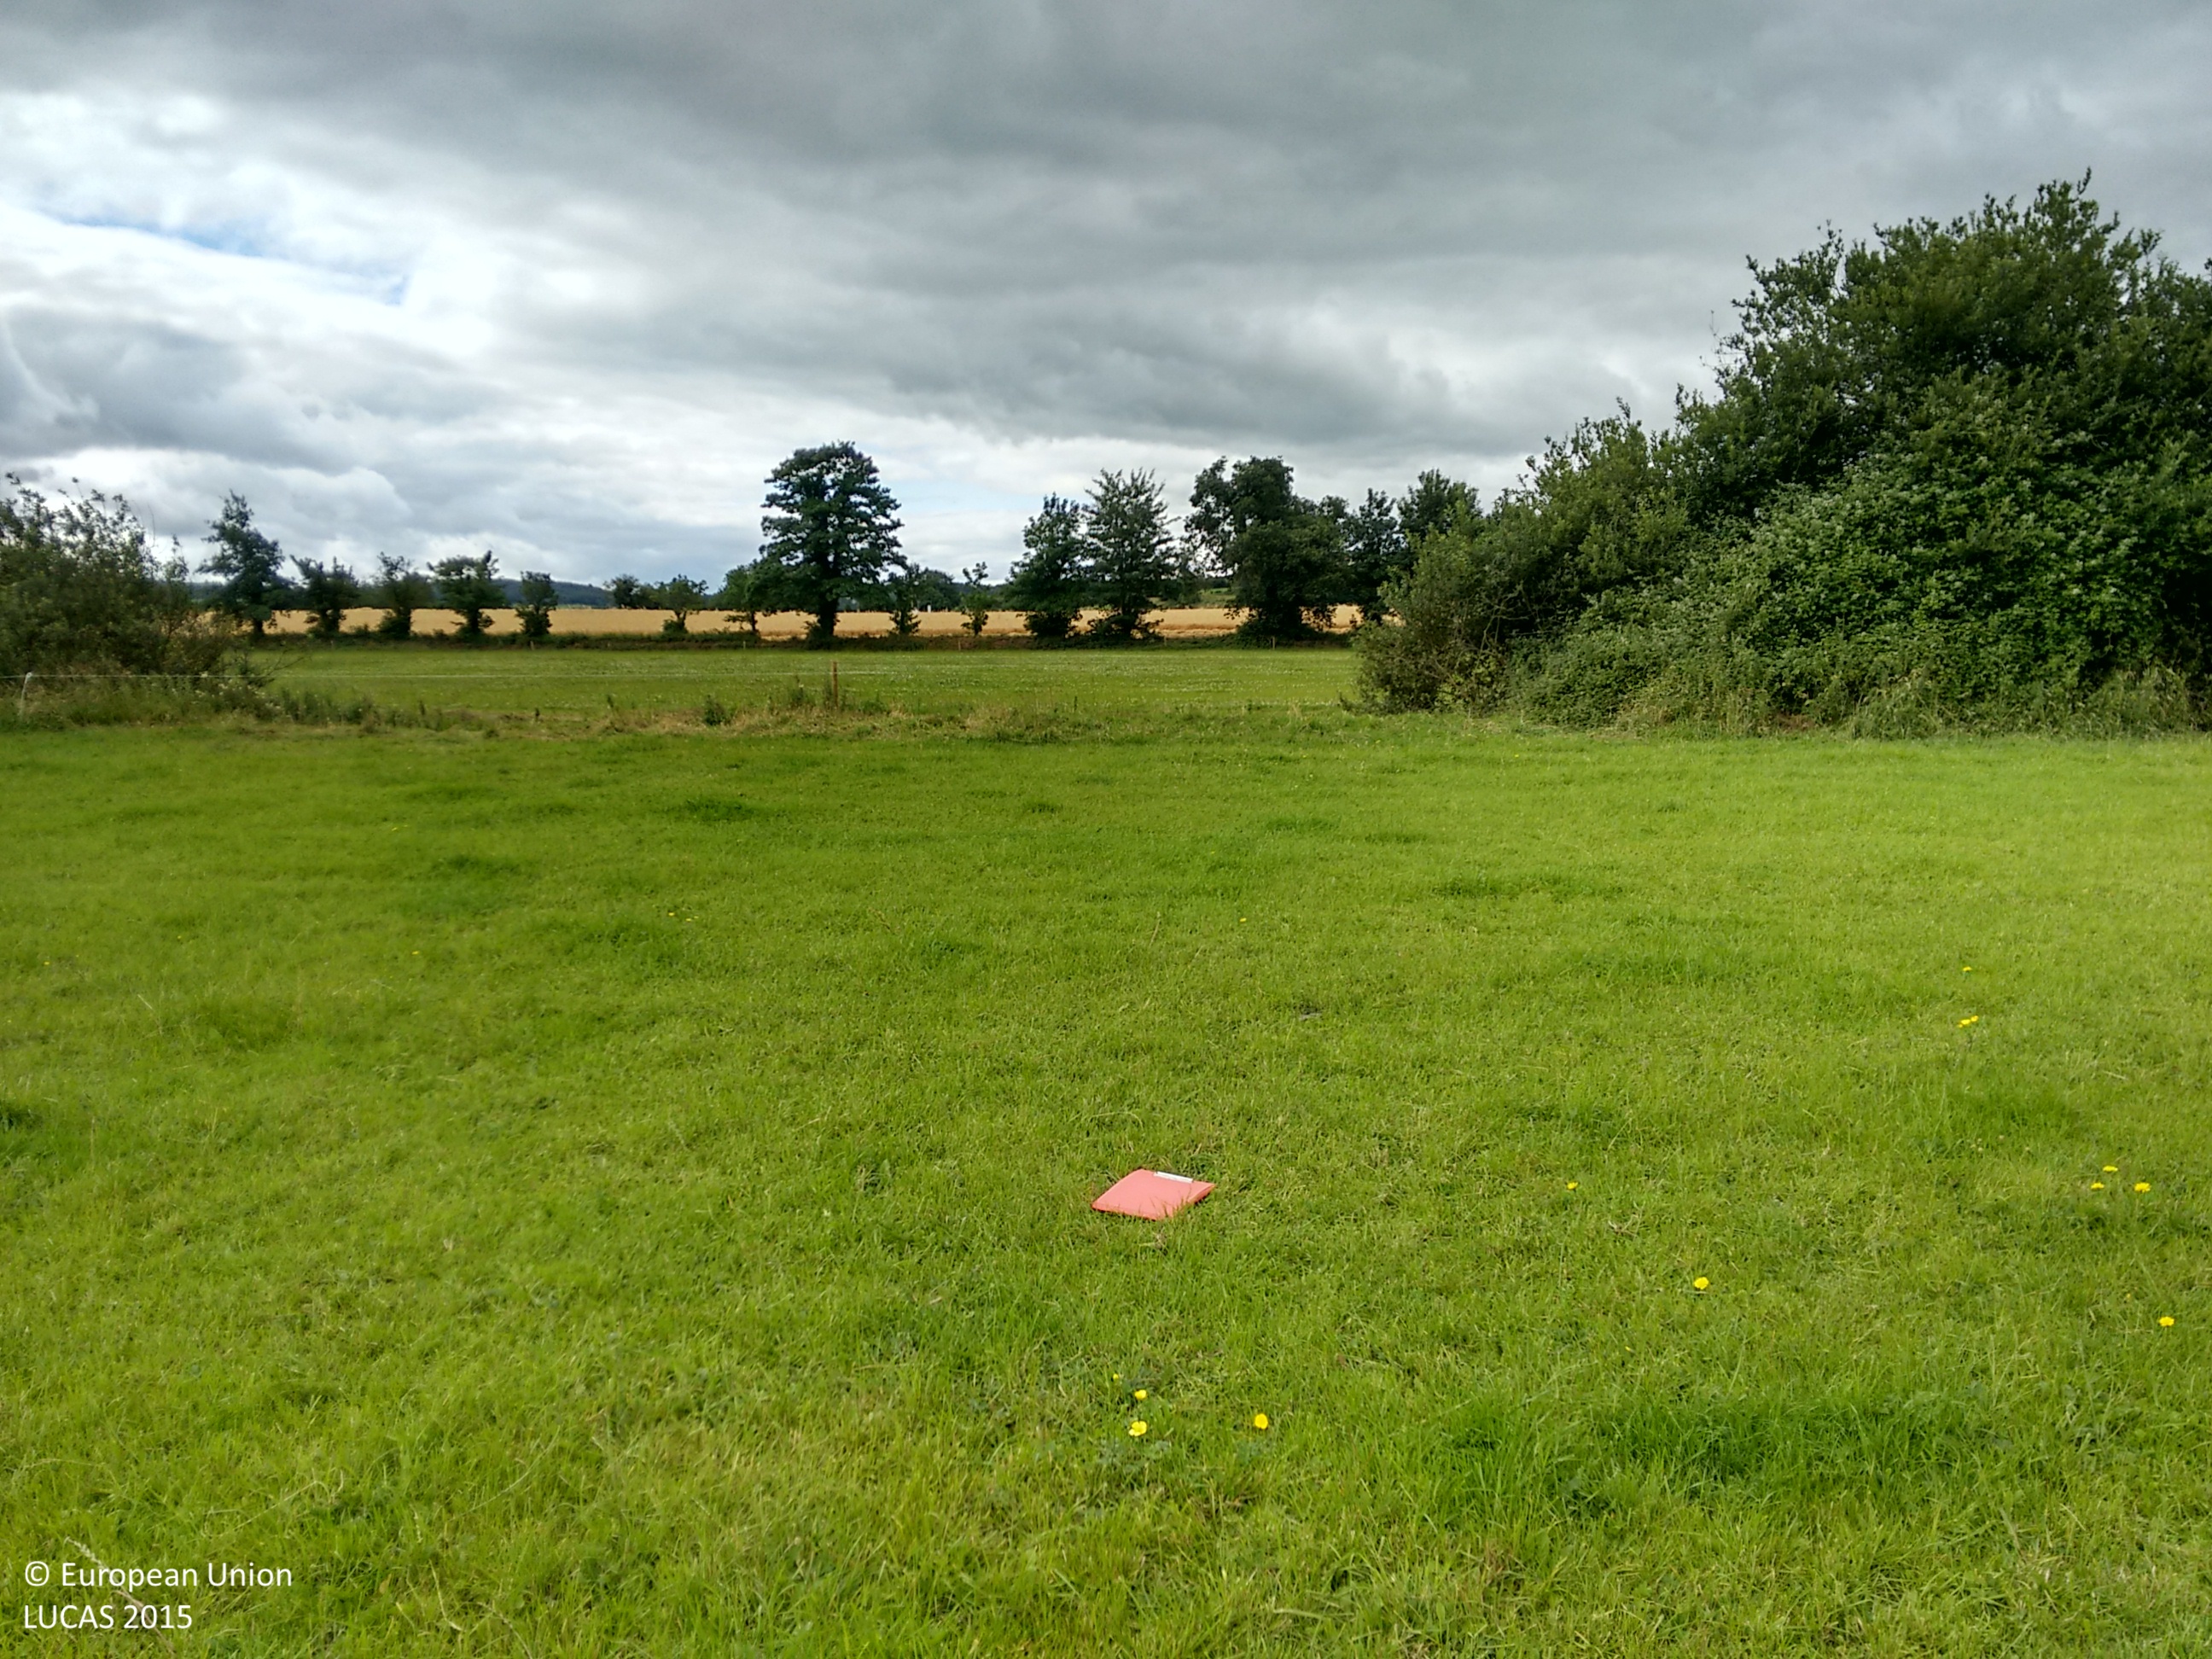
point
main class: Grassland
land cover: Grassland without tree/shrub cover
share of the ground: > 75 %
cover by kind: herbaceous plants 100 %
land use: Agriculture (excluding fallow land and kitchen gardens)
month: July
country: IE
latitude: 52.7253
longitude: -7.3443
